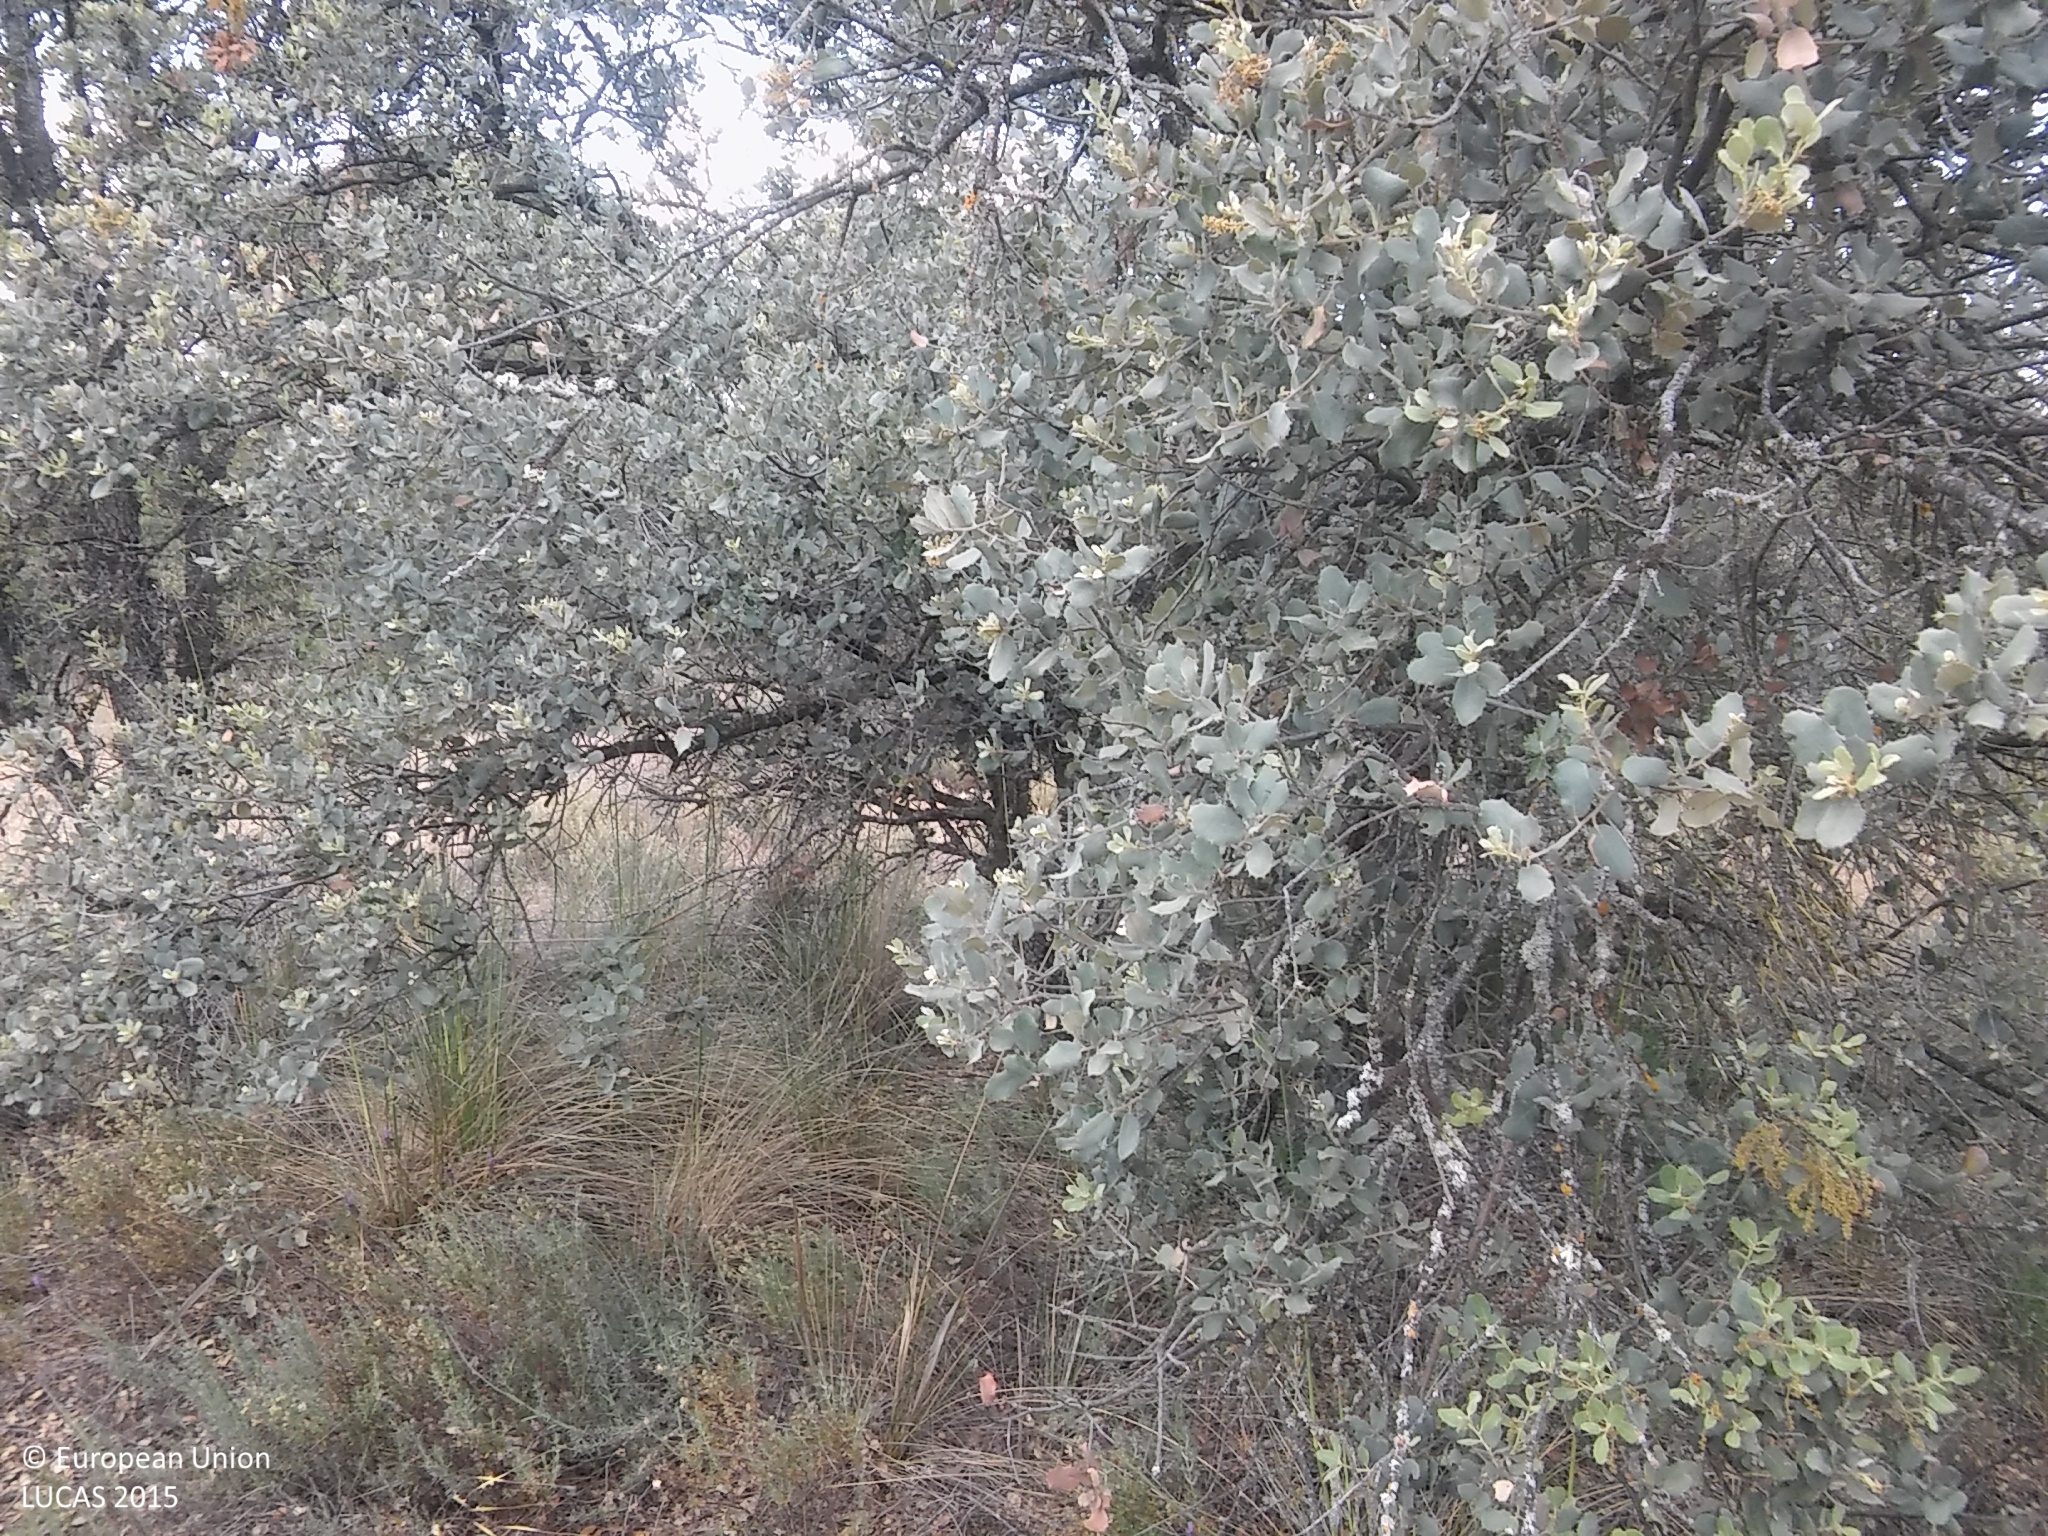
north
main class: Woodland
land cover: Broadleaved woodland
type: broadleaved evergreen forest
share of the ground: 25 - 50 %
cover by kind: broadleaved forest trees 30 %, shrubs 30 %, unconsolidated bare surface 30 %, coniferous forest trees 10 %
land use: Forestry
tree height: > 5 m
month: June
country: ES
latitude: 41.6557
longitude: -3.7550
